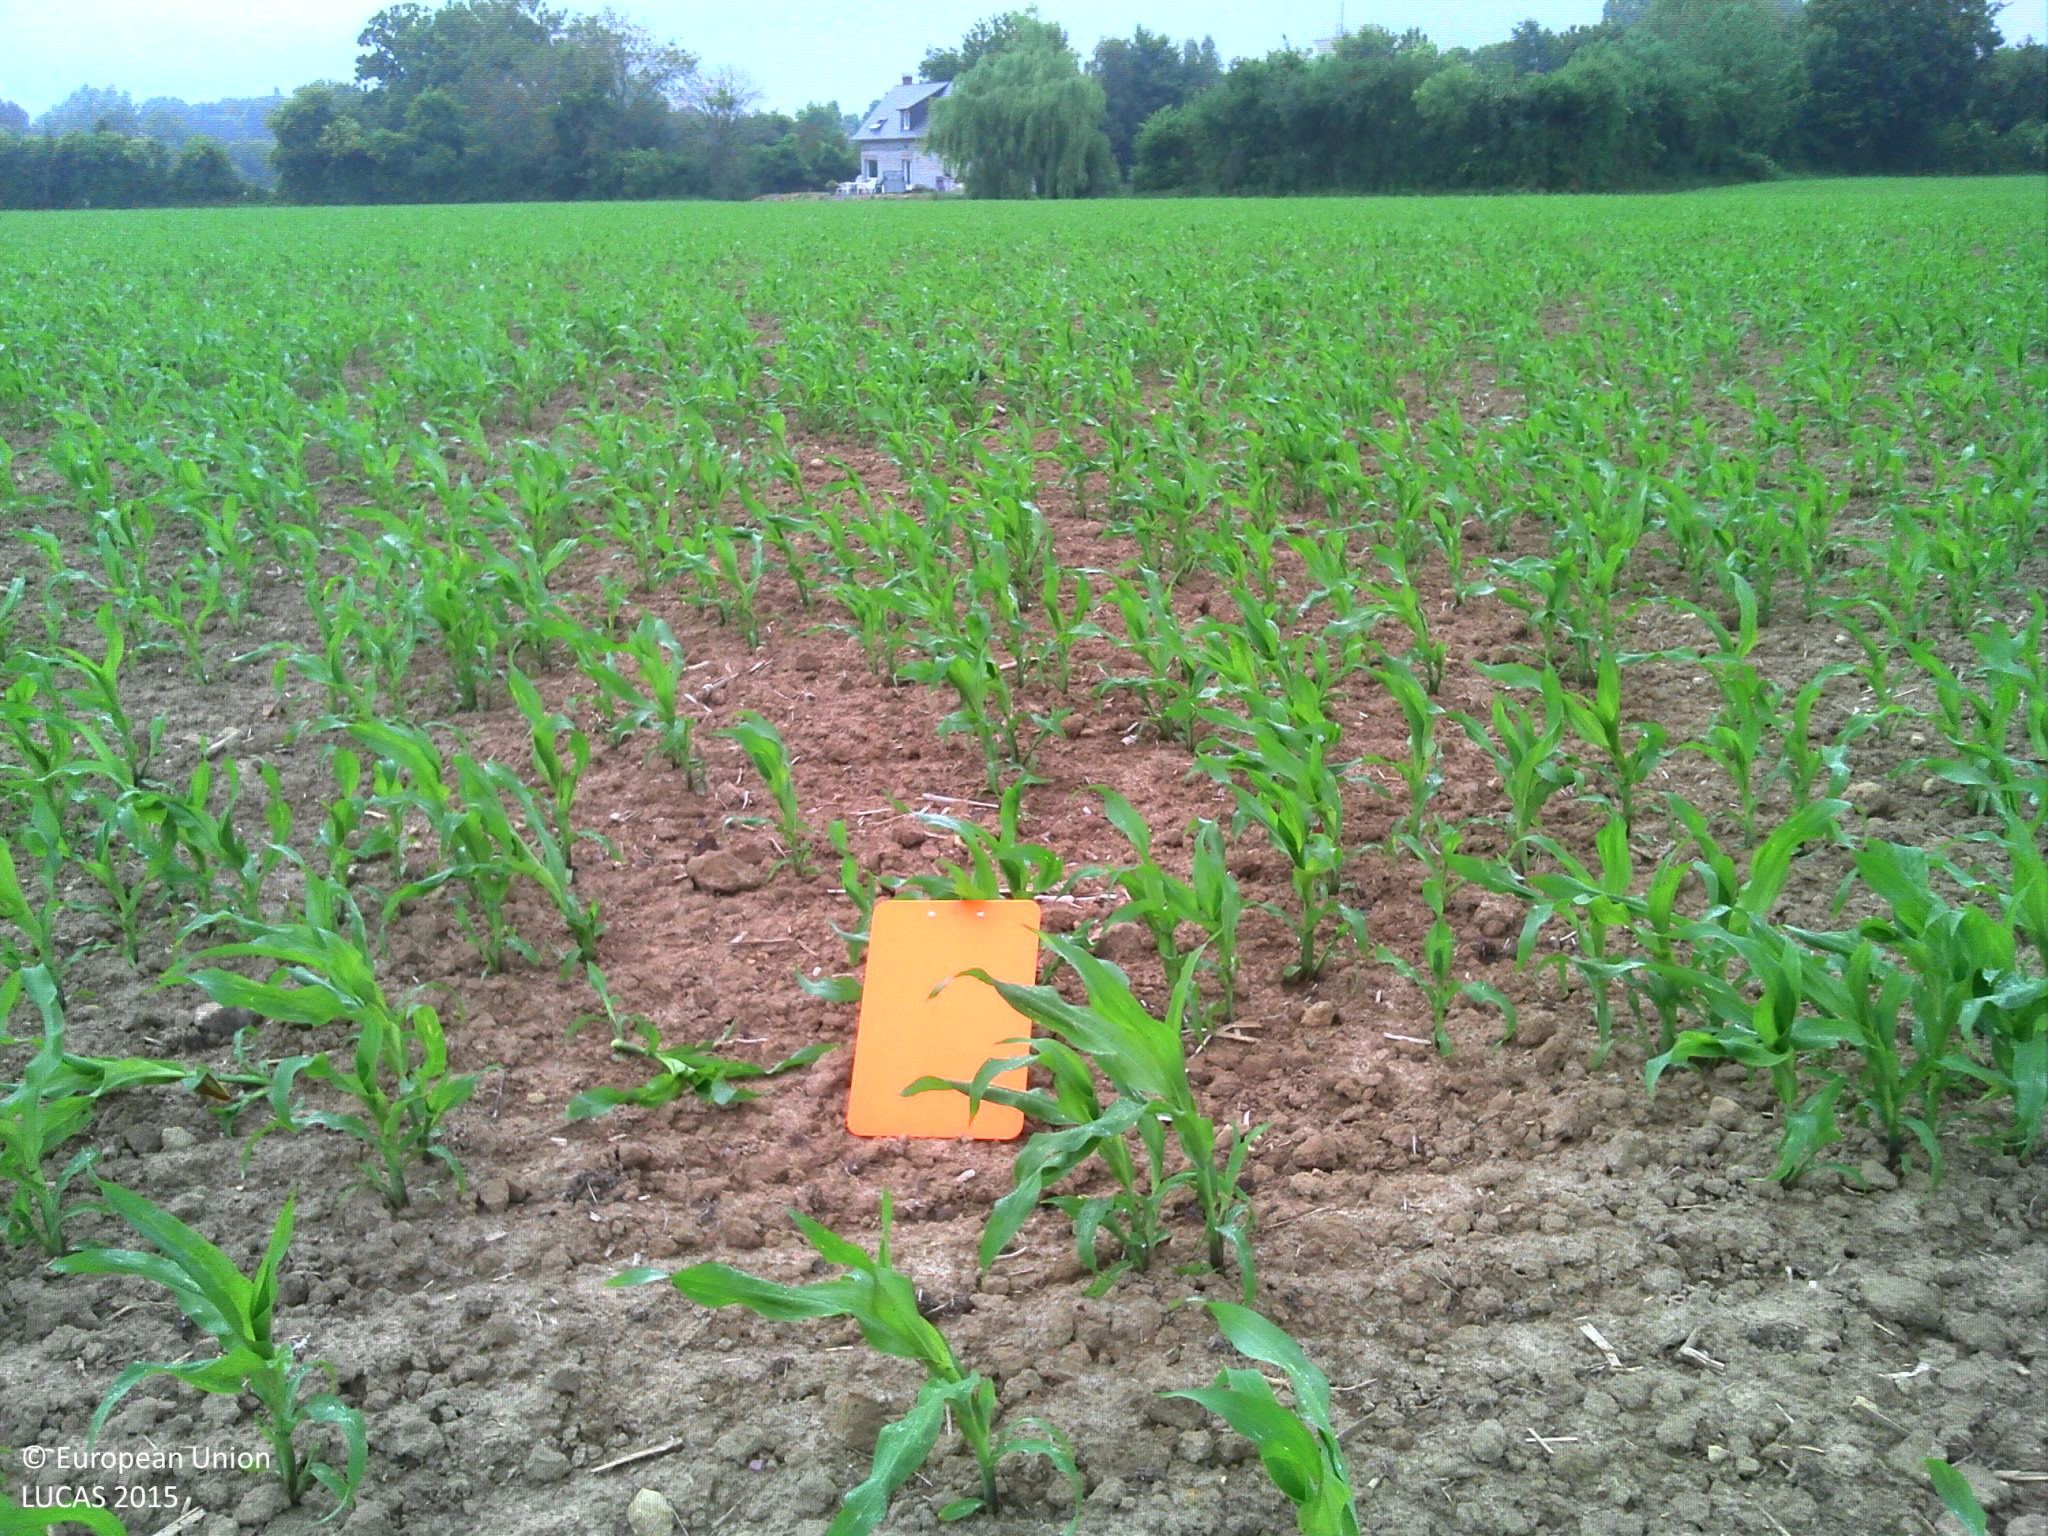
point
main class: Cropland
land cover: Maize
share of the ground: 10 - 25 %
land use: Agriculture (excluding fallow land and kitchen gardens)
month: June
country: FR
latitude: 49.2702
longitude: -0.0230
